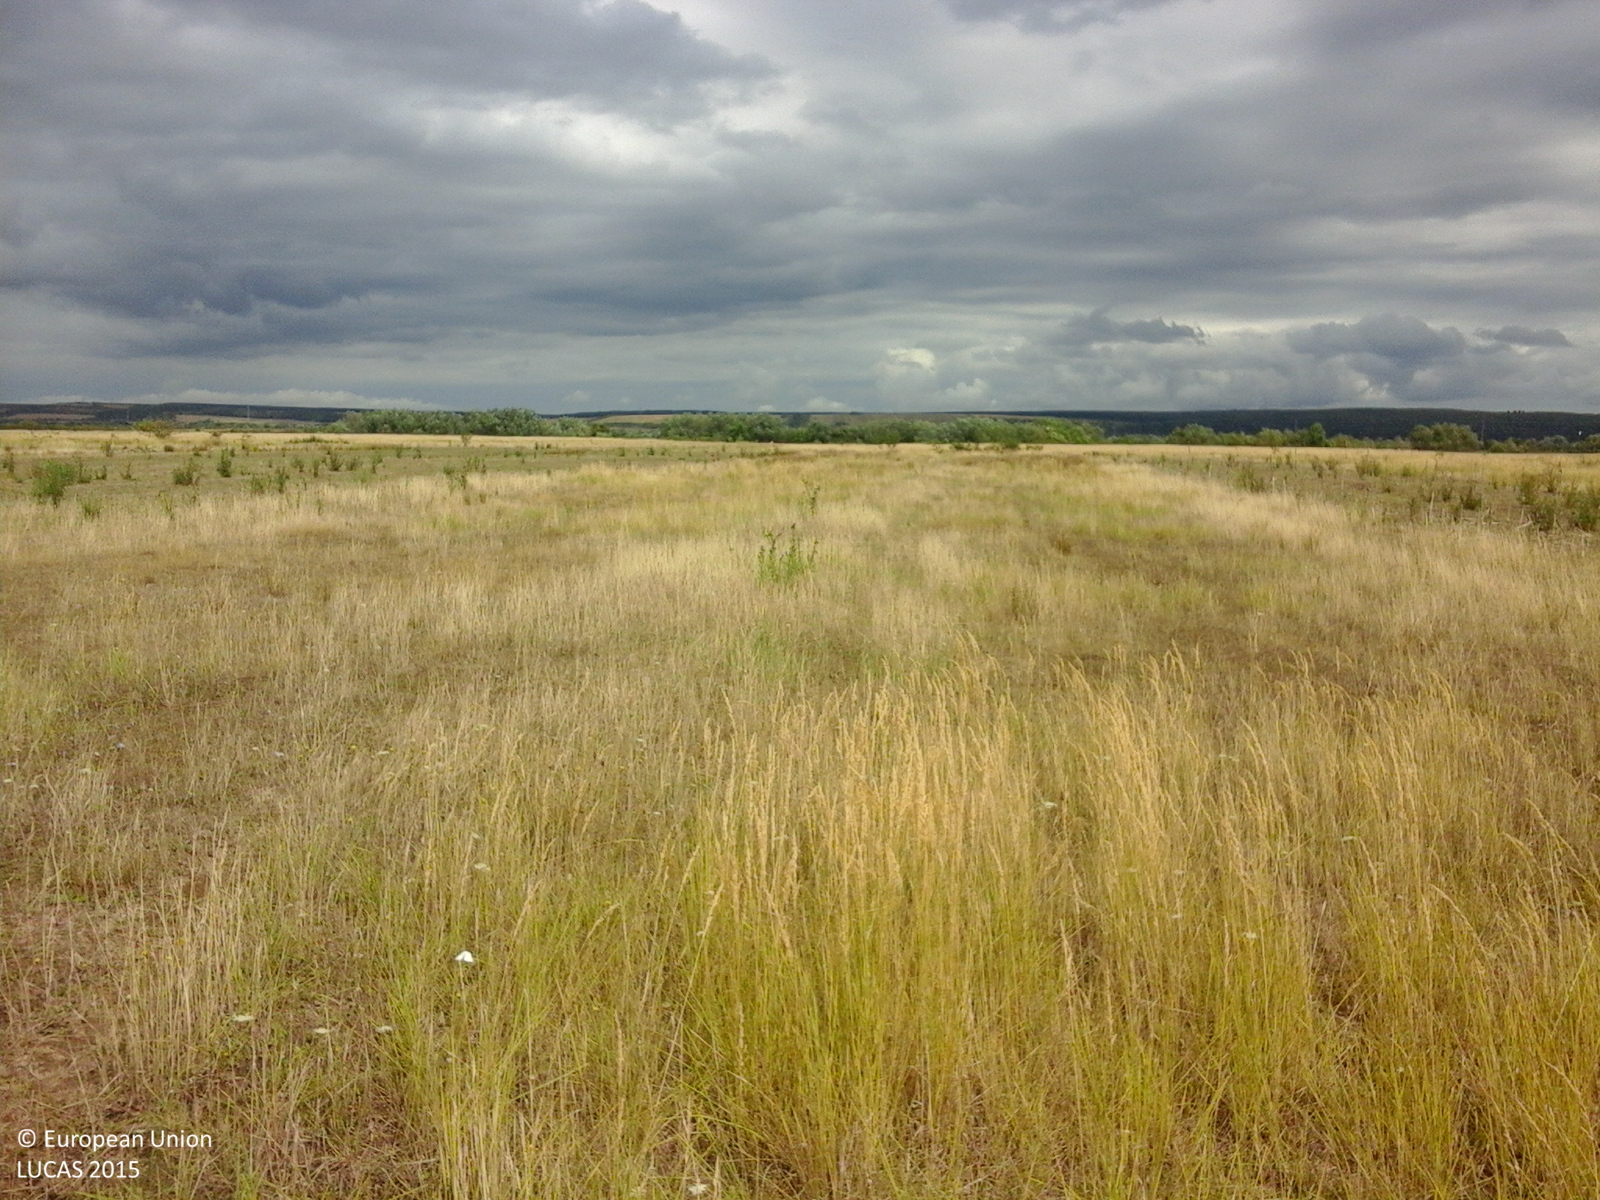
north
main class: Grassland
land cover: Grassland without tree/shrub cover
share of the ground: > 75 %
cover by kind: herbaceous plants 100 %
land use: Agriculture (excluding fallow land and kitchen gardens)
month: August
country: RO
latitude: 45.4267
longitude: 21.5999
